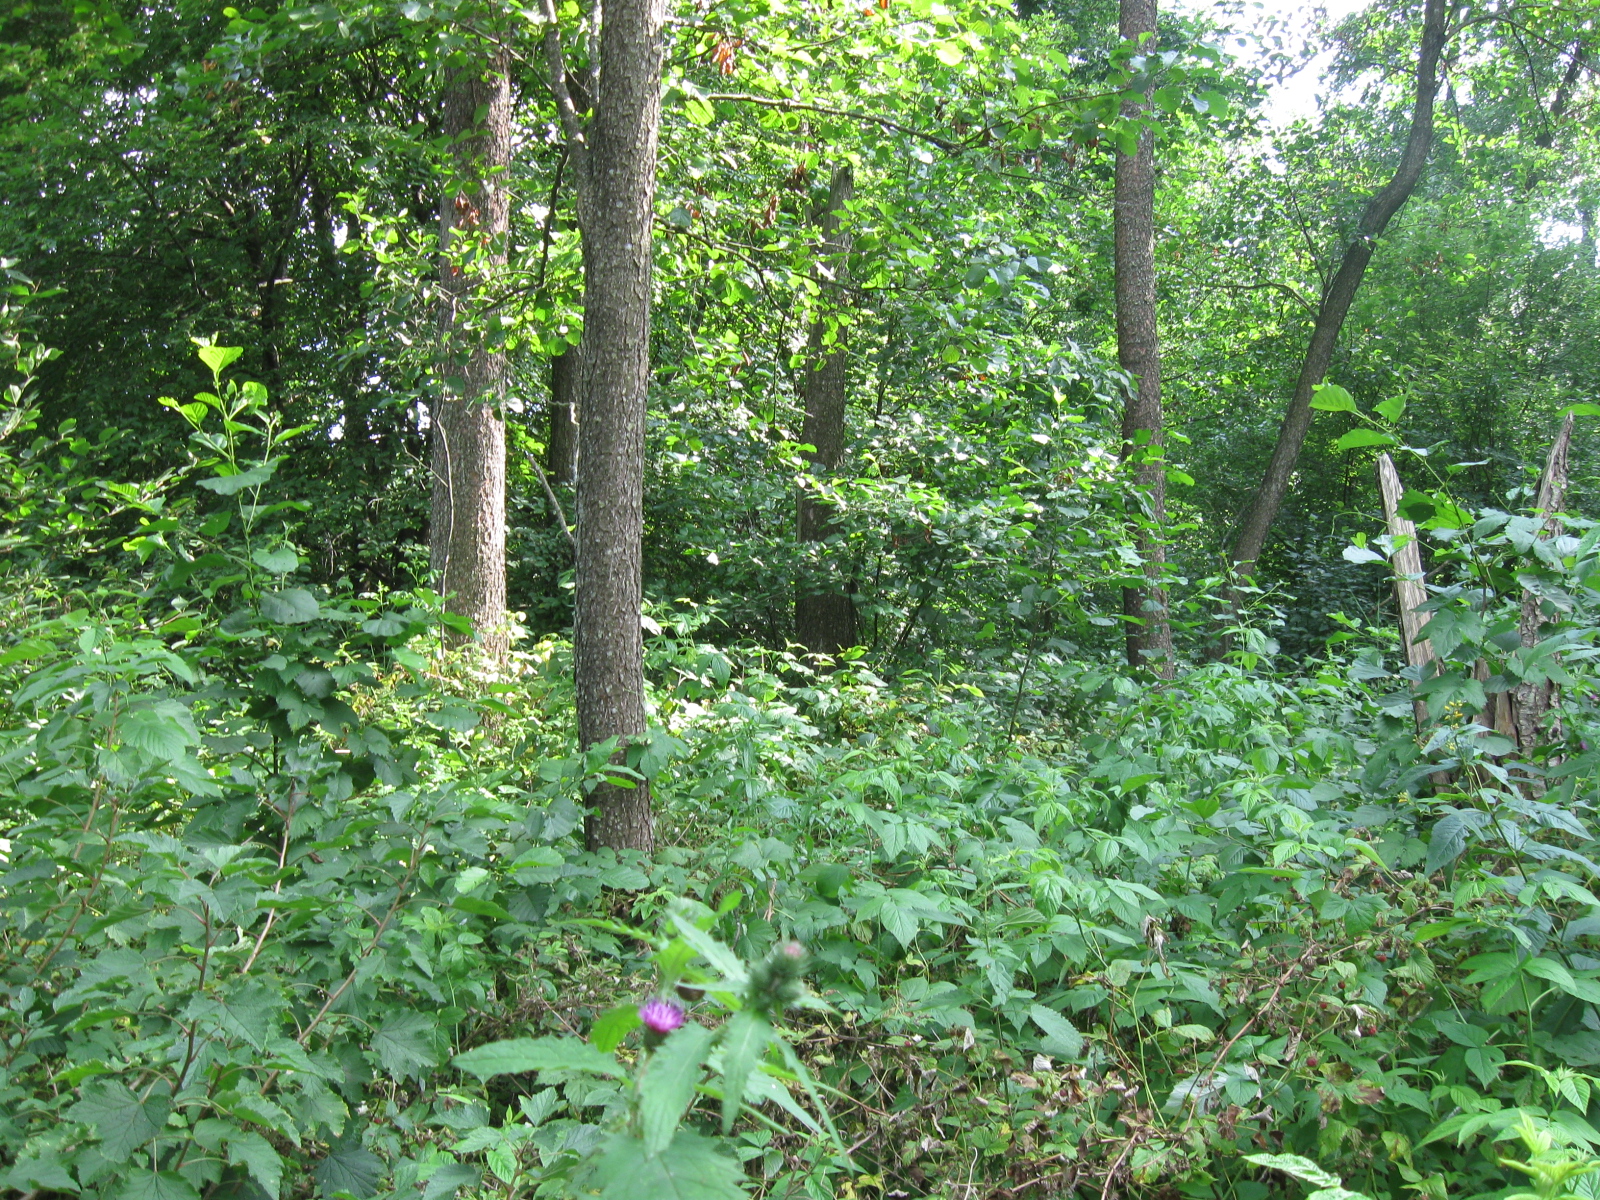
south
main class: Woodland
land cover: Broadleaved woodland
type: mire and swamp forests
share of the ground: > 75 %
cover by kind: broadleaved forest trees 75 %, shrubs 20 %, herbaceous plants 5 %
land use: Forestry
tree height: > 5 m
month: July
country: LT
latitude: 54.5287
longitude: 24.3939
